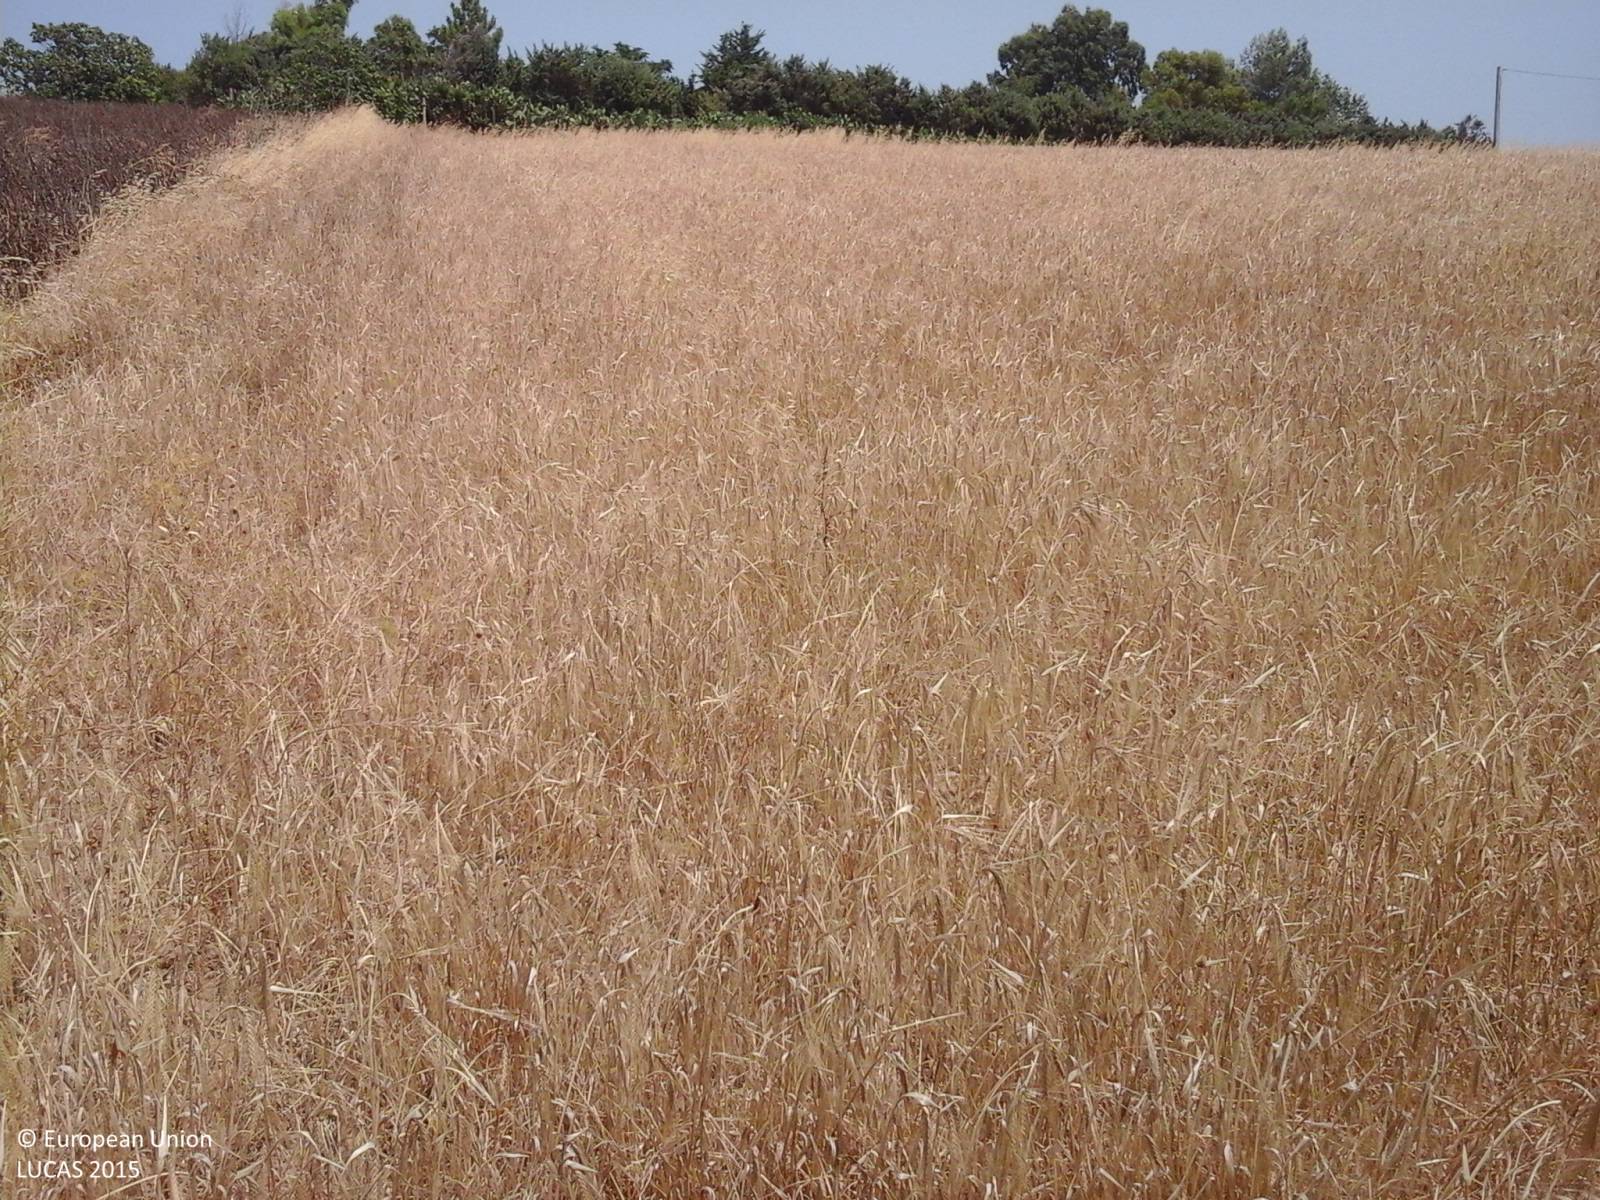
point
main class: Cropland
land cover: Barley
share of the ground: > 75 %
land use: Agriculture (excluding fallow land and kitchen gardens)
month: July
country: IT
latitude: 39.6084
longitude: 8.8305
